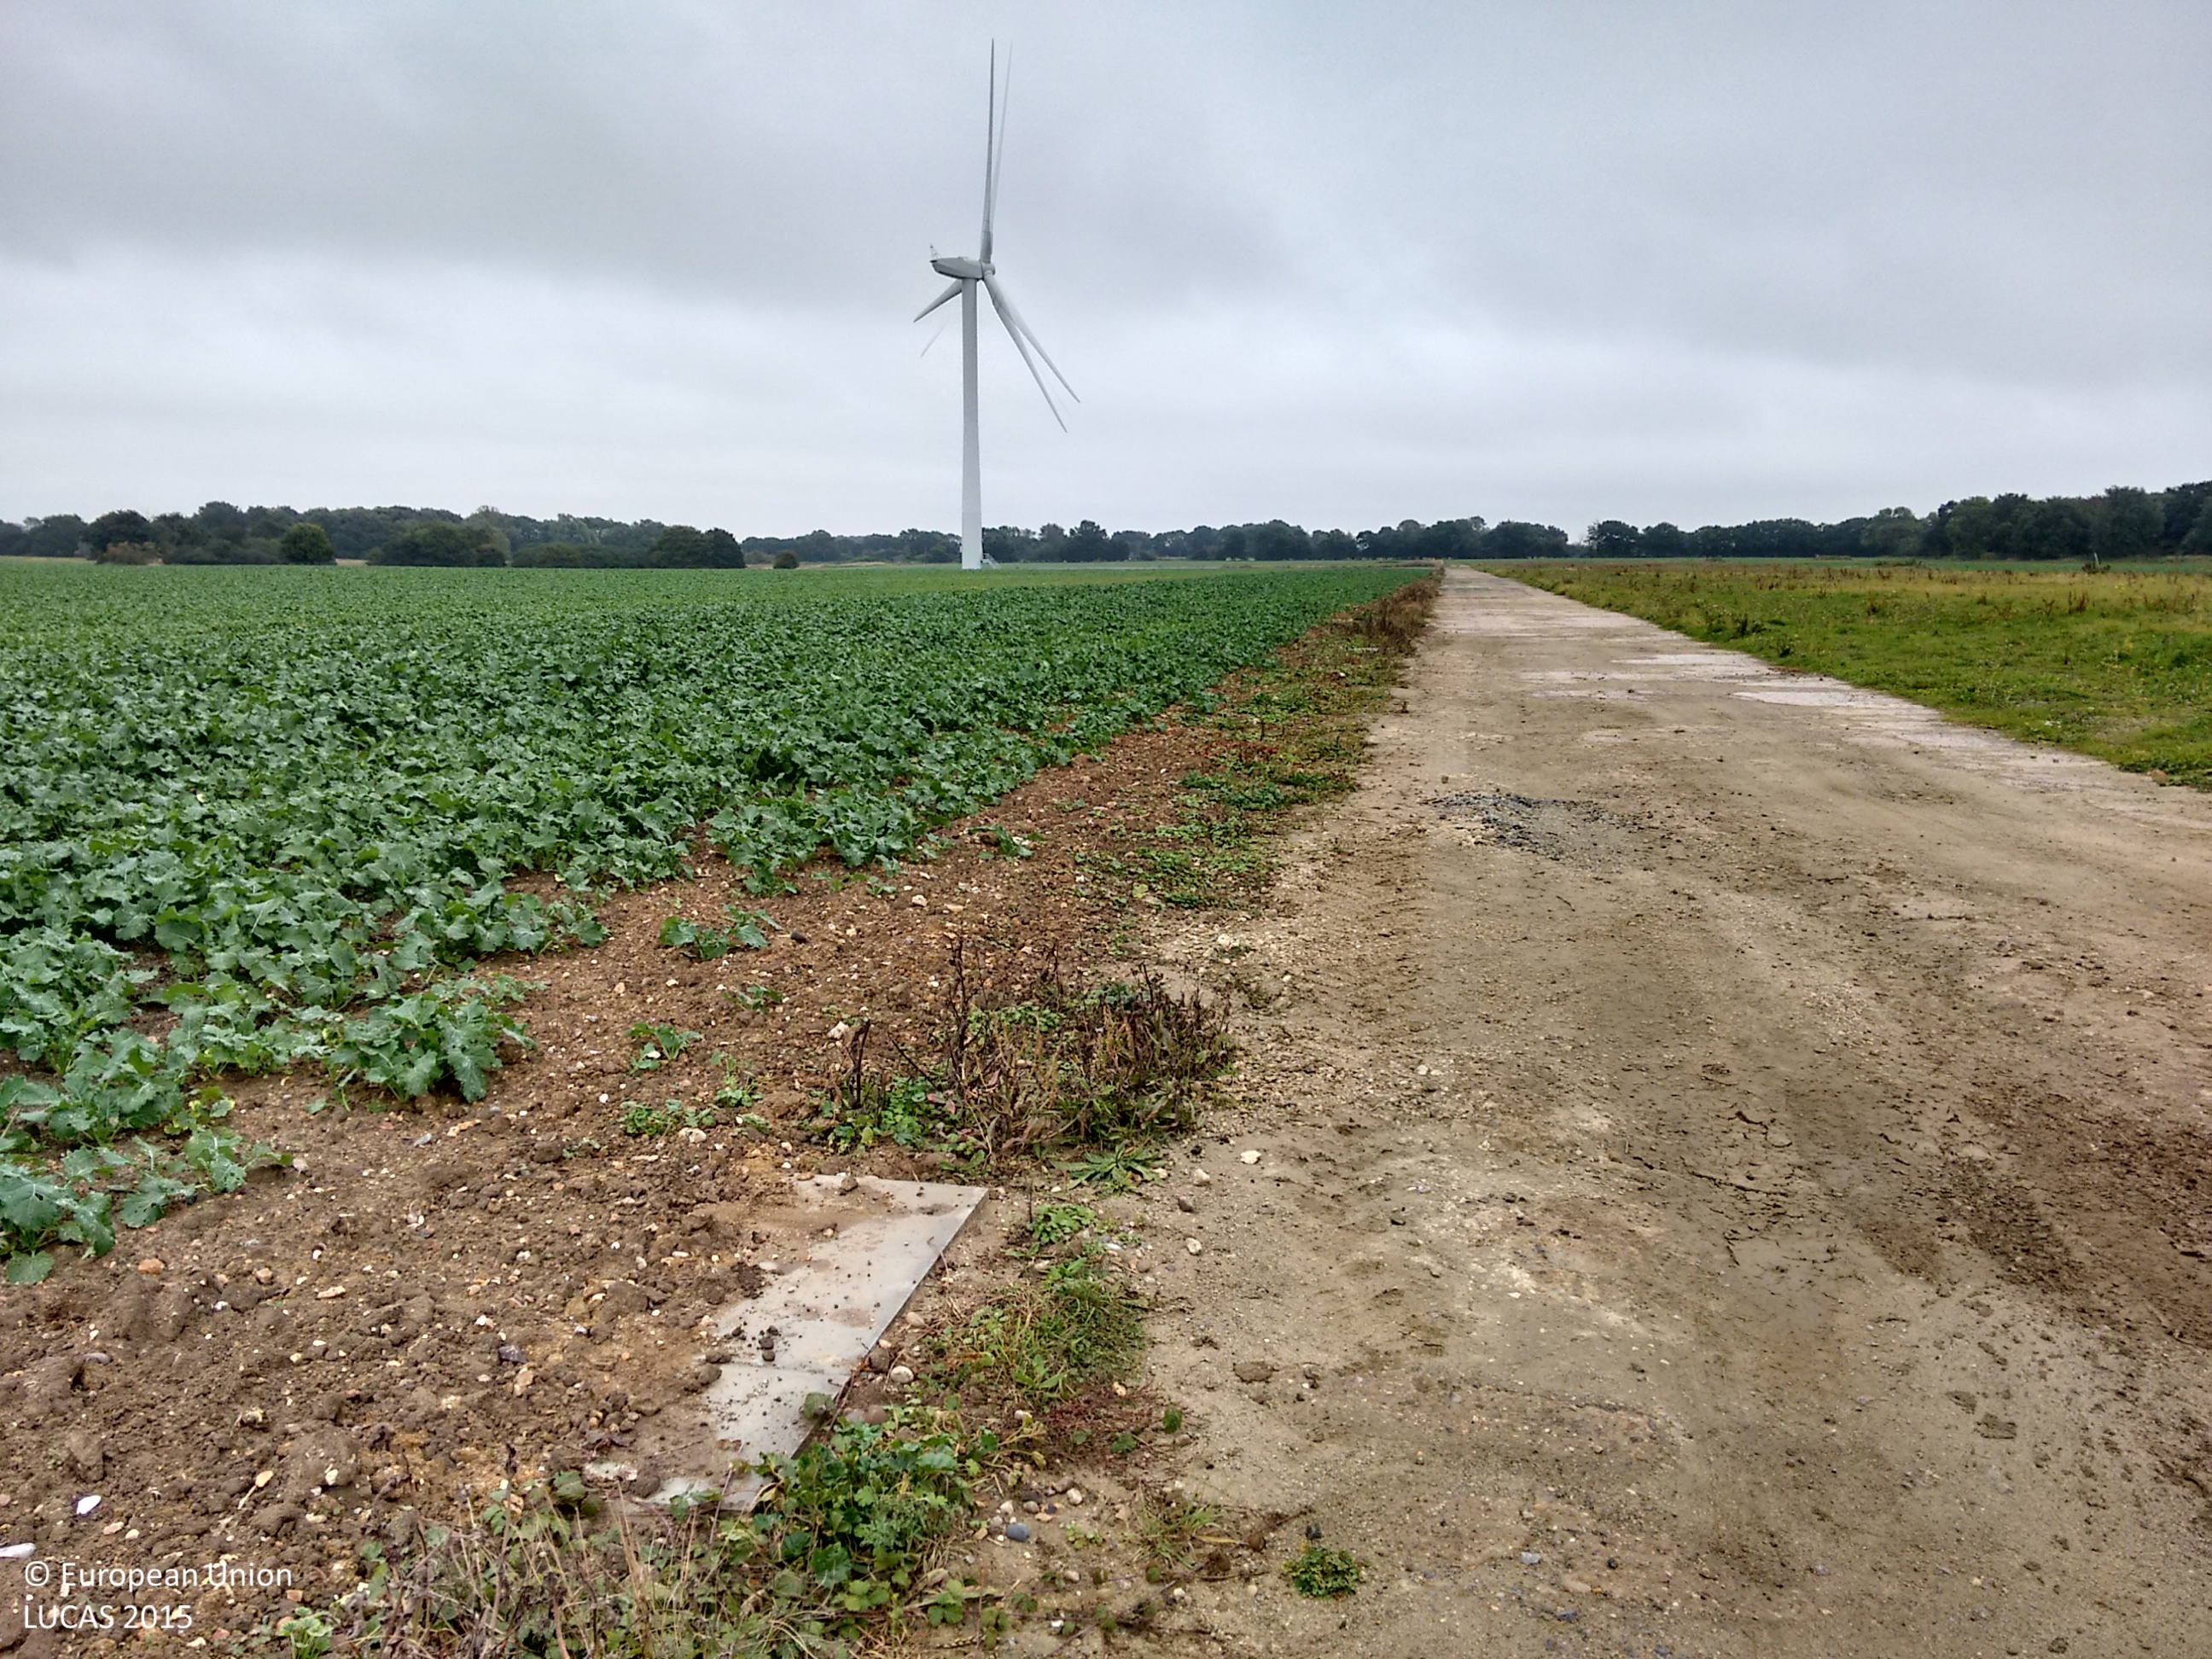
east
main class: Cropland
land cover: Rape and turnip rape
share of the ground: > 75 %
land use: Agriculture (excluding fallow land and kitchen gardens)
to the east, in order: Rape and turnip rape; Broadleaved woodland; Grassland without tree/shrub cover; Rape and turnip rape
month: October
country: GB
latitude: 52.3642
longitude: 1.5370
